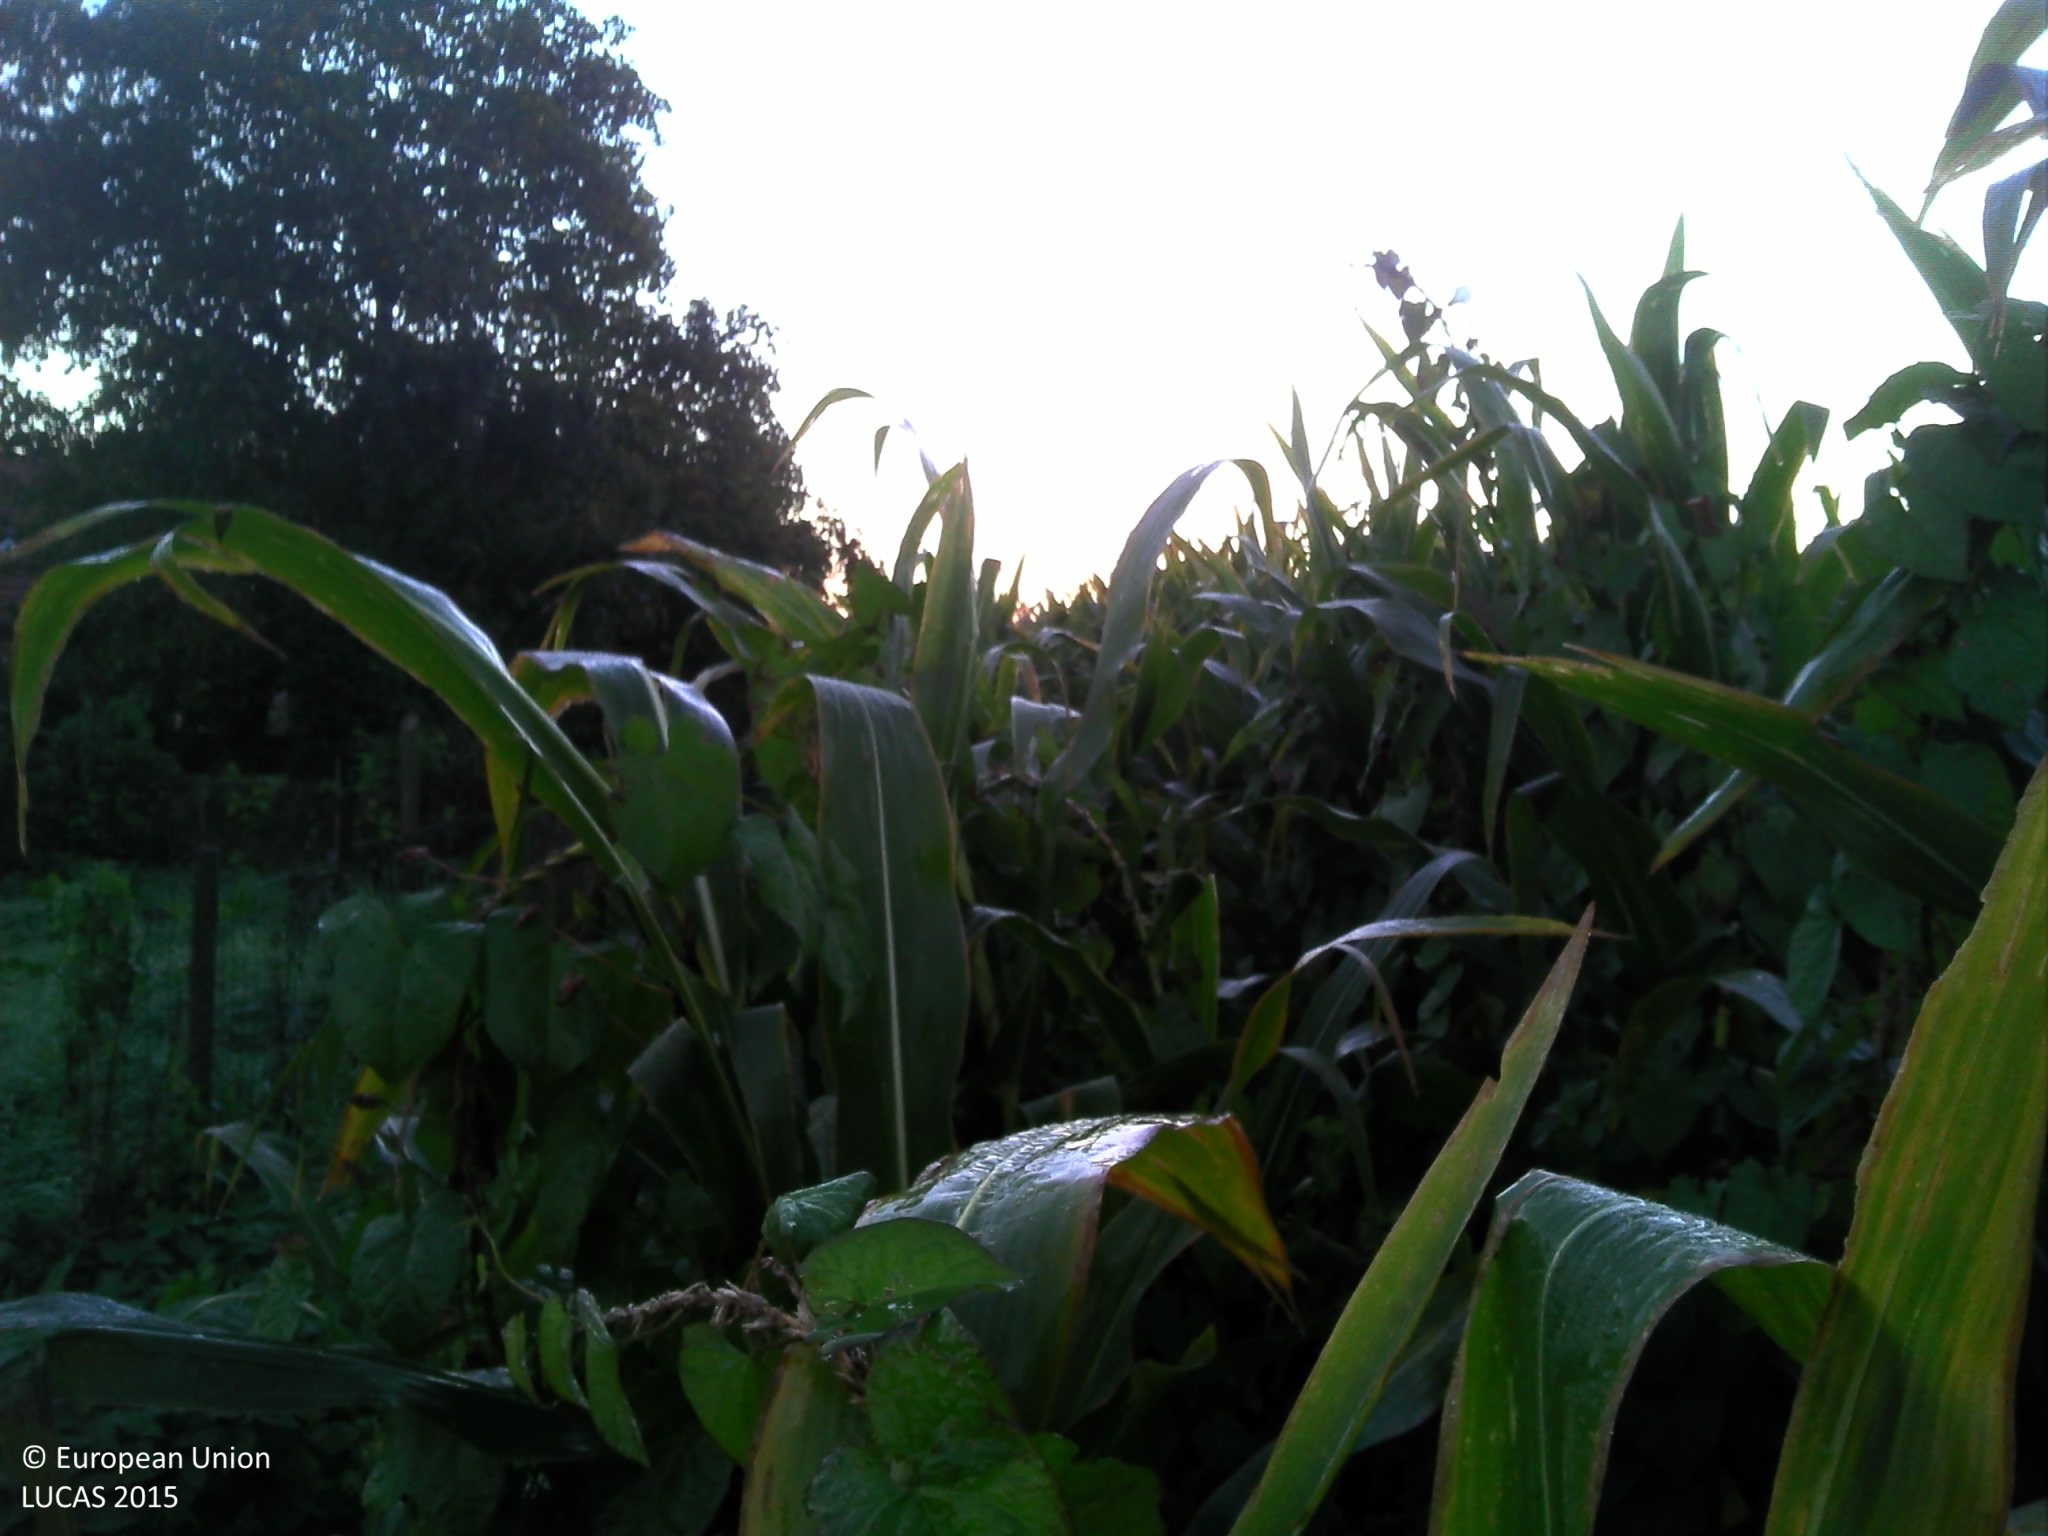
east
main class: Grassland
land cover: Spontaneously vegetated surfaces
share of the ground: > 75 %
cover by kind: herbaceous plants 80 %, unconsolidated bare surface 20 %
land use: Residential
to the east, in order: Spontaneously vegetated surfaces; Maize; Grass margins; Ditches and canals; Grass margins; Paved roads, cycling and walking lanes; Grass margins; Ditches and canals; Electric lines; Fences; Grassland without tree/shrub cover; Fences; Grass margins; Maize; Grass margins; Abandoned hedges; Artificial constructions in urban areas
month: September
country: BE
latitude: 51.1519
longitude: 4.5202
